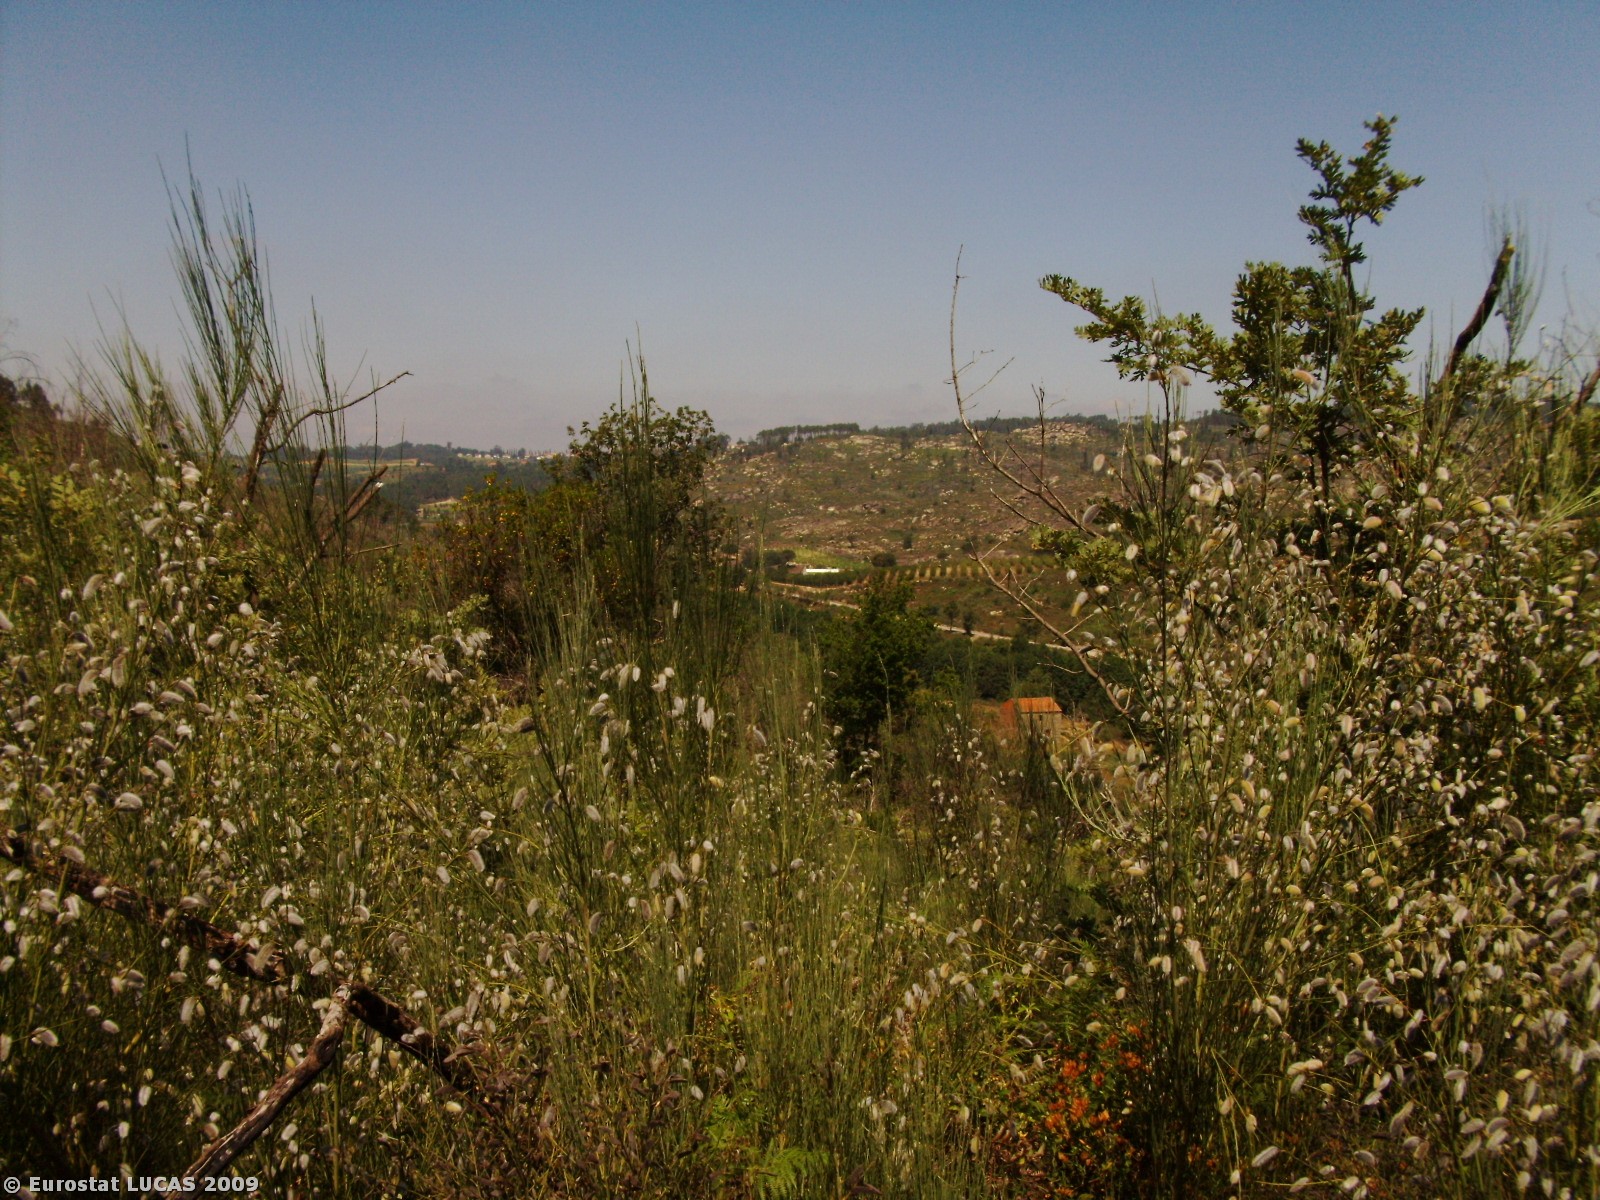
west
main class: Woodland
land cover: Broadleaved woodland
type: mesophytic deciduous forest
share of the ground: 10 - 25 %
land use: Forestry
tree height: > 5 m
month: July
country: PT
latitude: 40.6634
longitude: -7.6595
